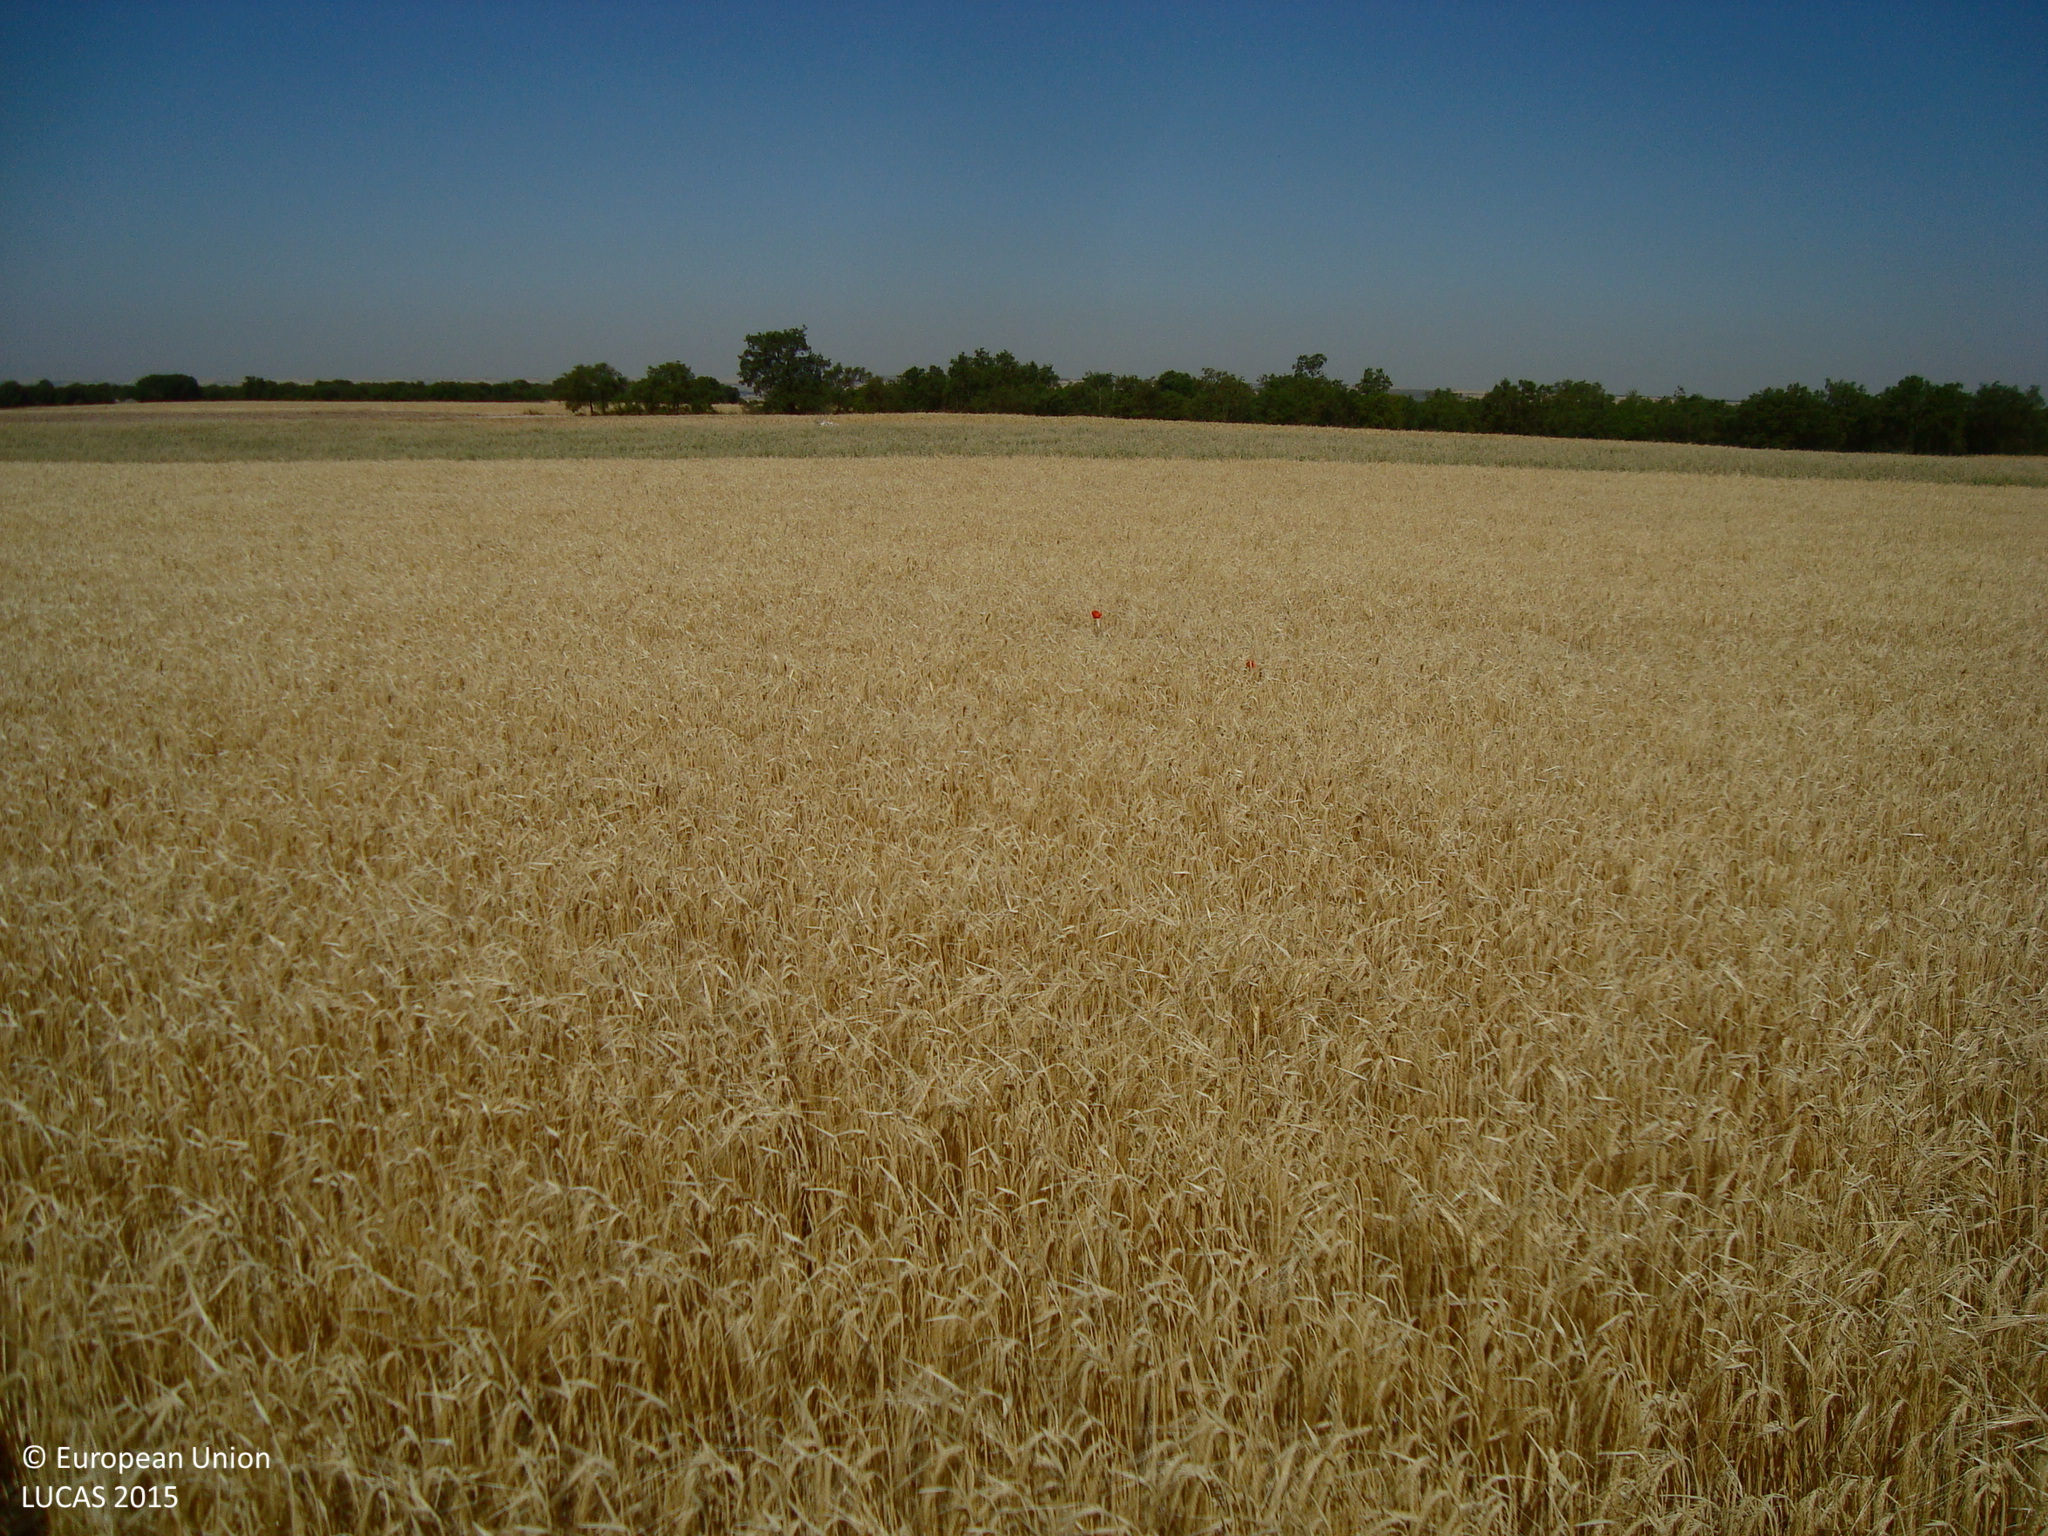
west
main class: Cropland
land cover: Barley
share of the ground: > 75 %
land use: Agriculture (excluding fallow land and kitchen gardens)
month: June
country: ES
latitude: 41.7877
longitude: -3.8584
